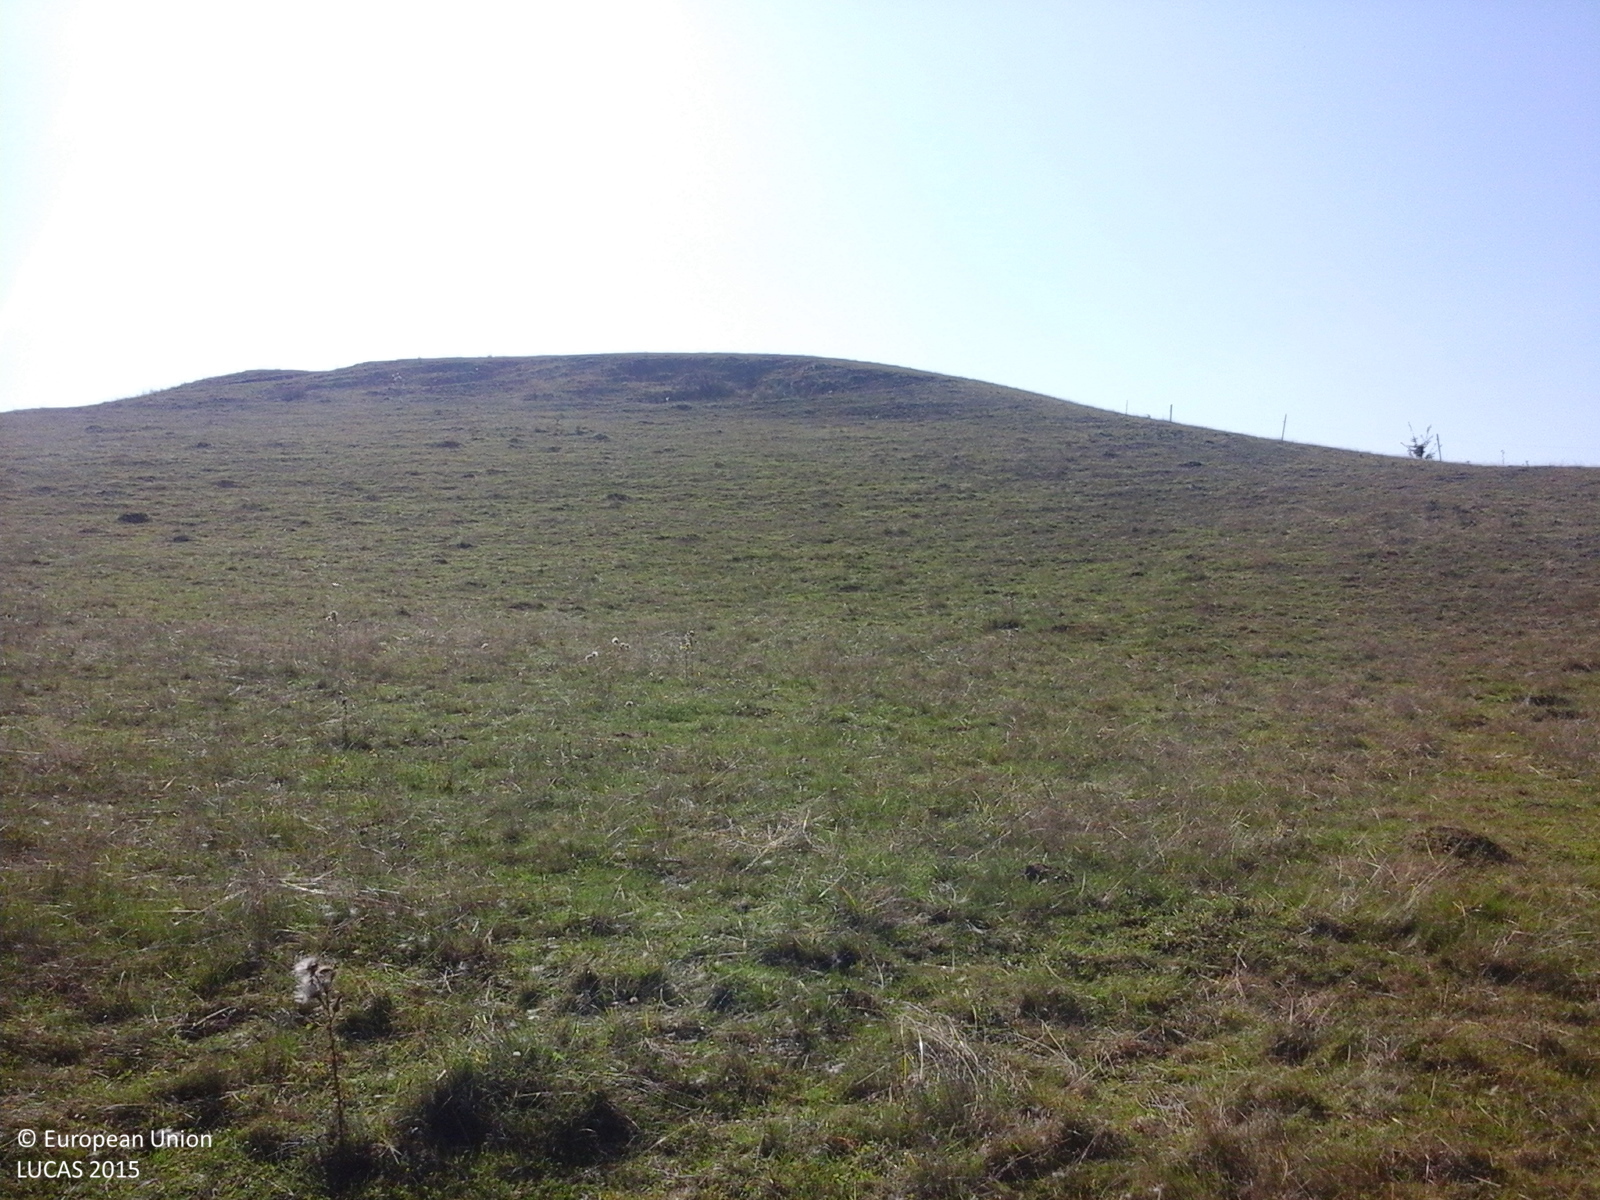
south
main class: Grassland
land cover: Grassland without tree/shrub cover
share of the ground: > 75 %
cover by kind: herbaceous plants 100 %
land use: Agriculture (excluding fallow land and kitchen gardens)
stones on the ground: < 10 %
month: October
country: RO
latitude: 46.2561
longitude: 23.6509
